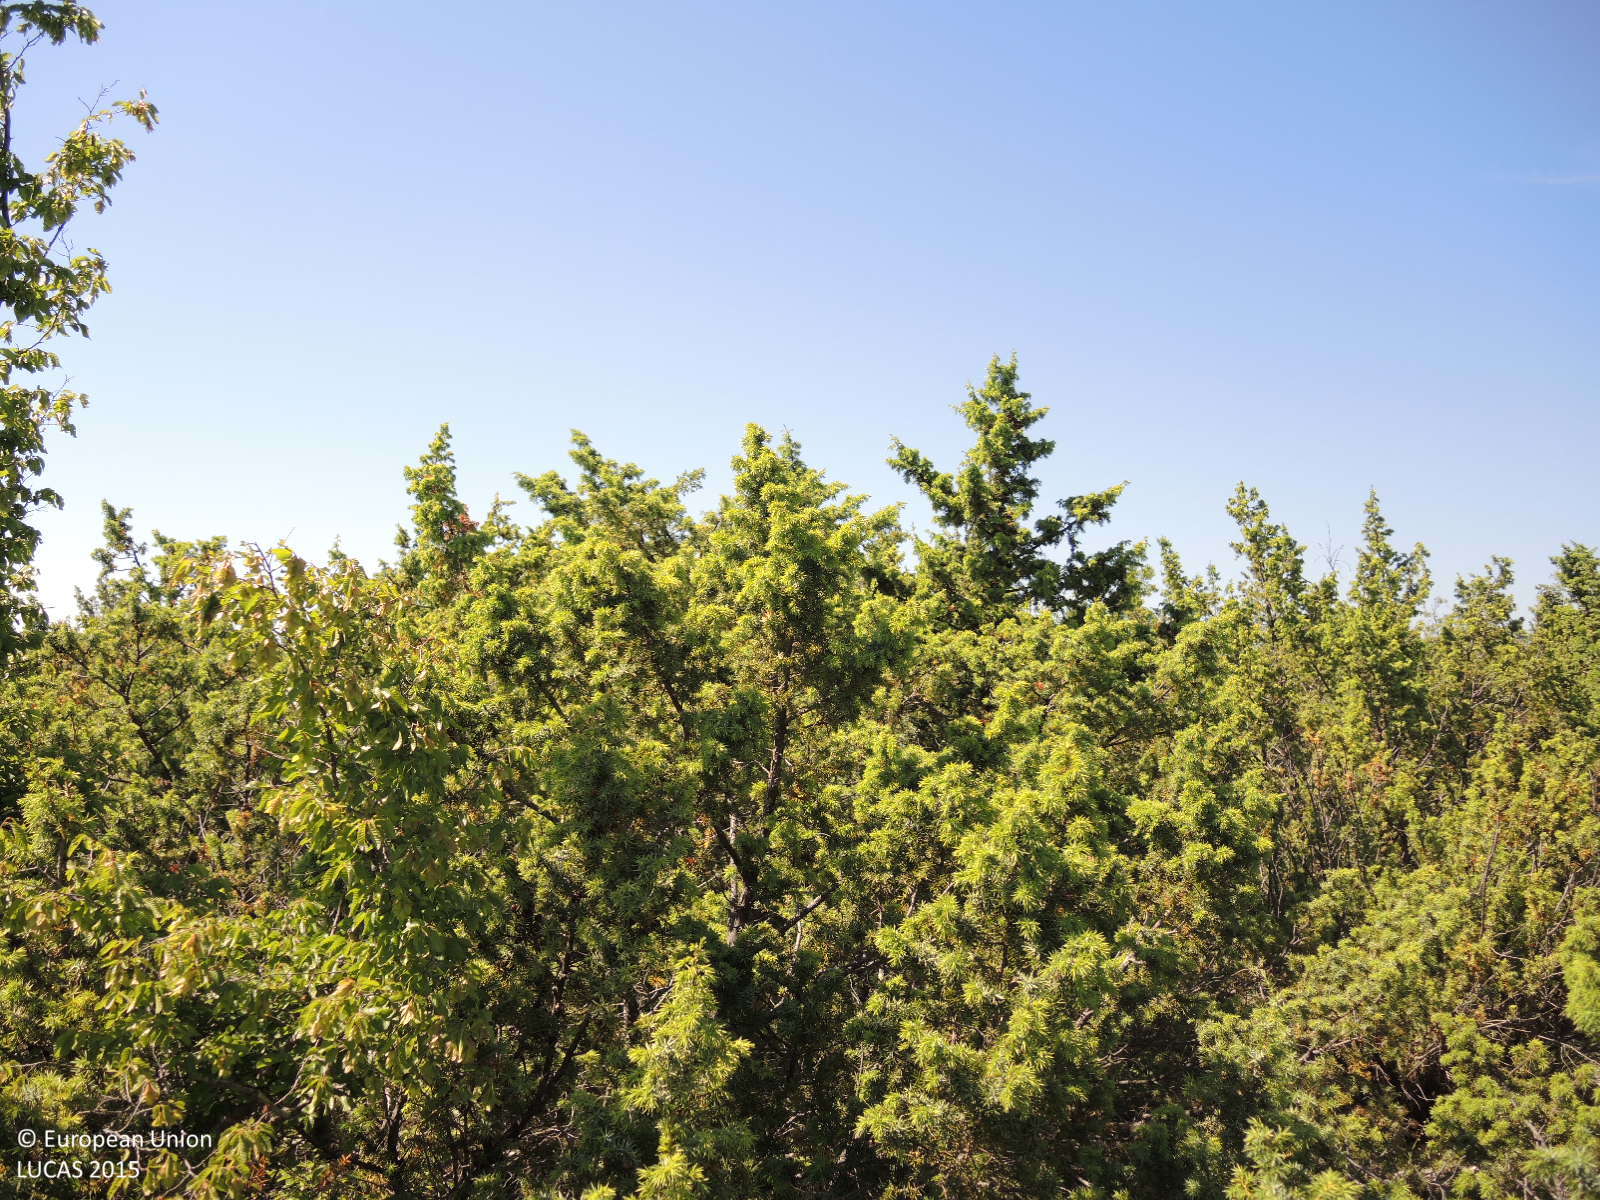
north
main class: Shrubland
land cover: Shrubland with sparse tree cover
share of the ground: > 75 %
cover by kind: shrubs 85 %, coniferous forest trees 5 %, herbaceous plants 5 %, unconsolidated bare surface 5 %
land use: Semi-natural and natural areas not in use
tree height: < 5 m
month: May
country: HR
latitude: 43.9456
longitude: 15.9350
